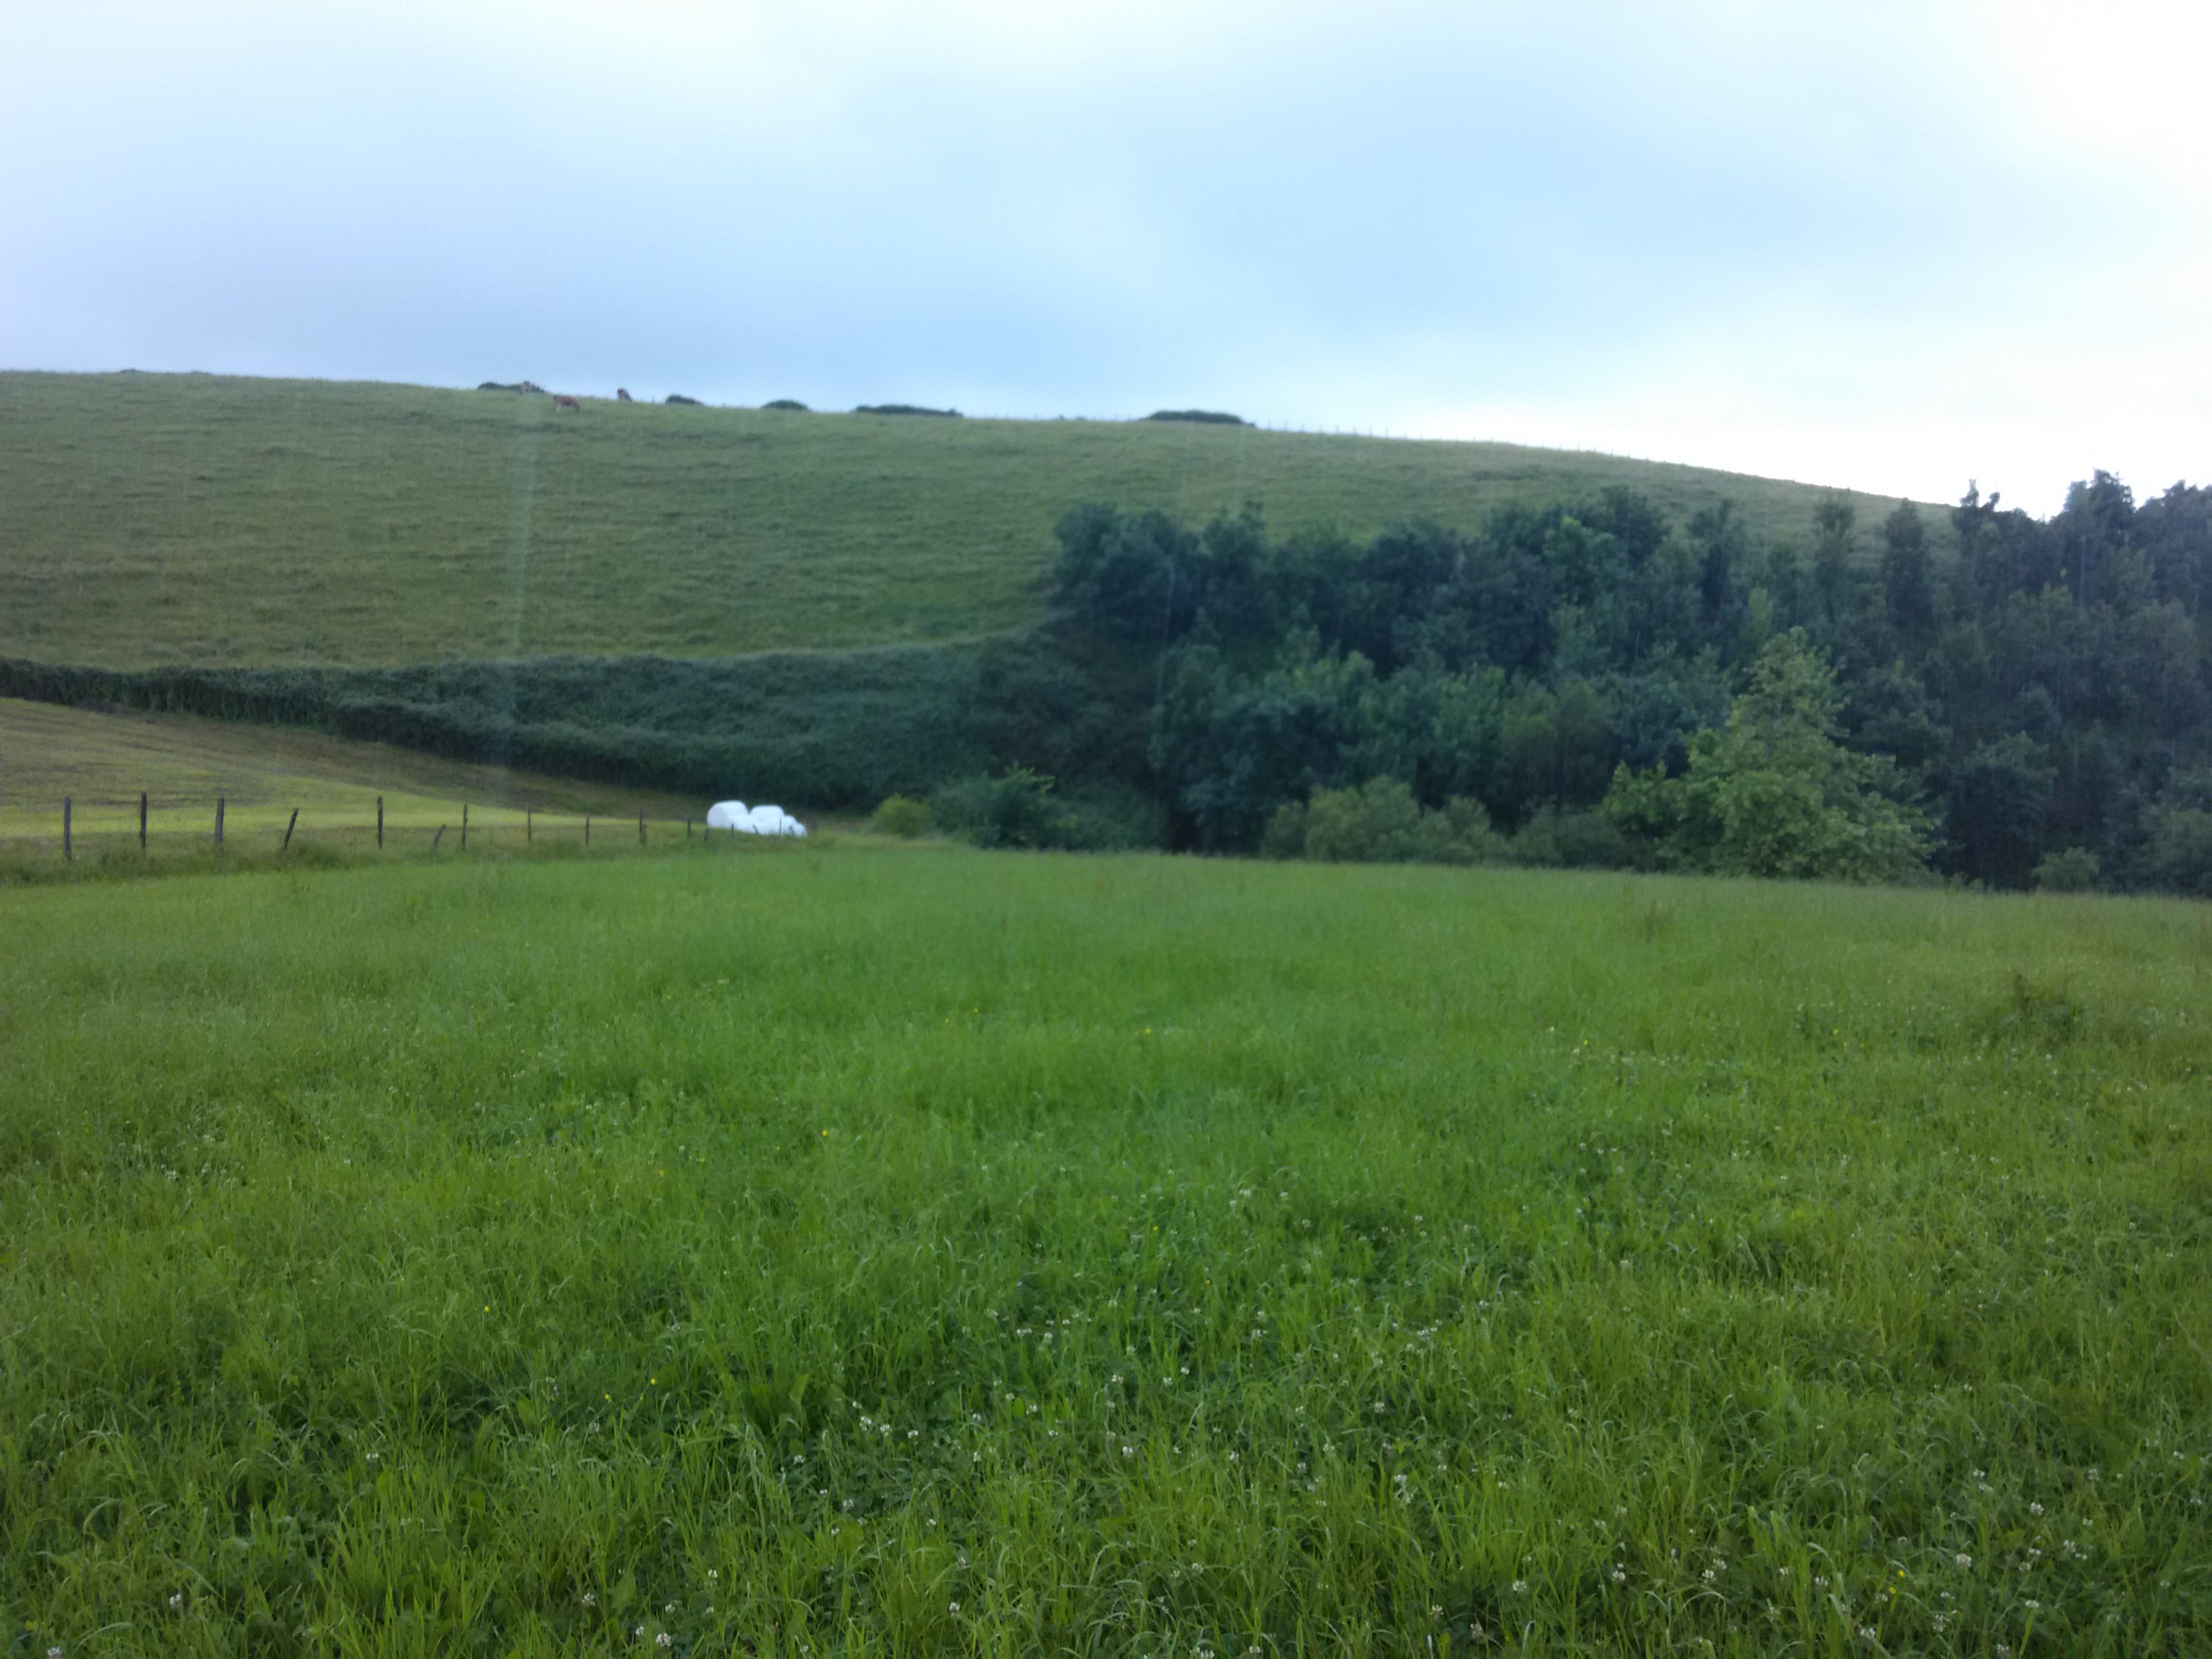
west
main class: Grassland
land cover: Grassland without tree/shrub cover
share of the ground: > 75 %
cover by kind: herbaceous plants 100 %
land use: Agriculture (excluding fallow land and kitchen gardens)
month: June
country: ES
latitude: 43.2889
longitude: -2.2889
